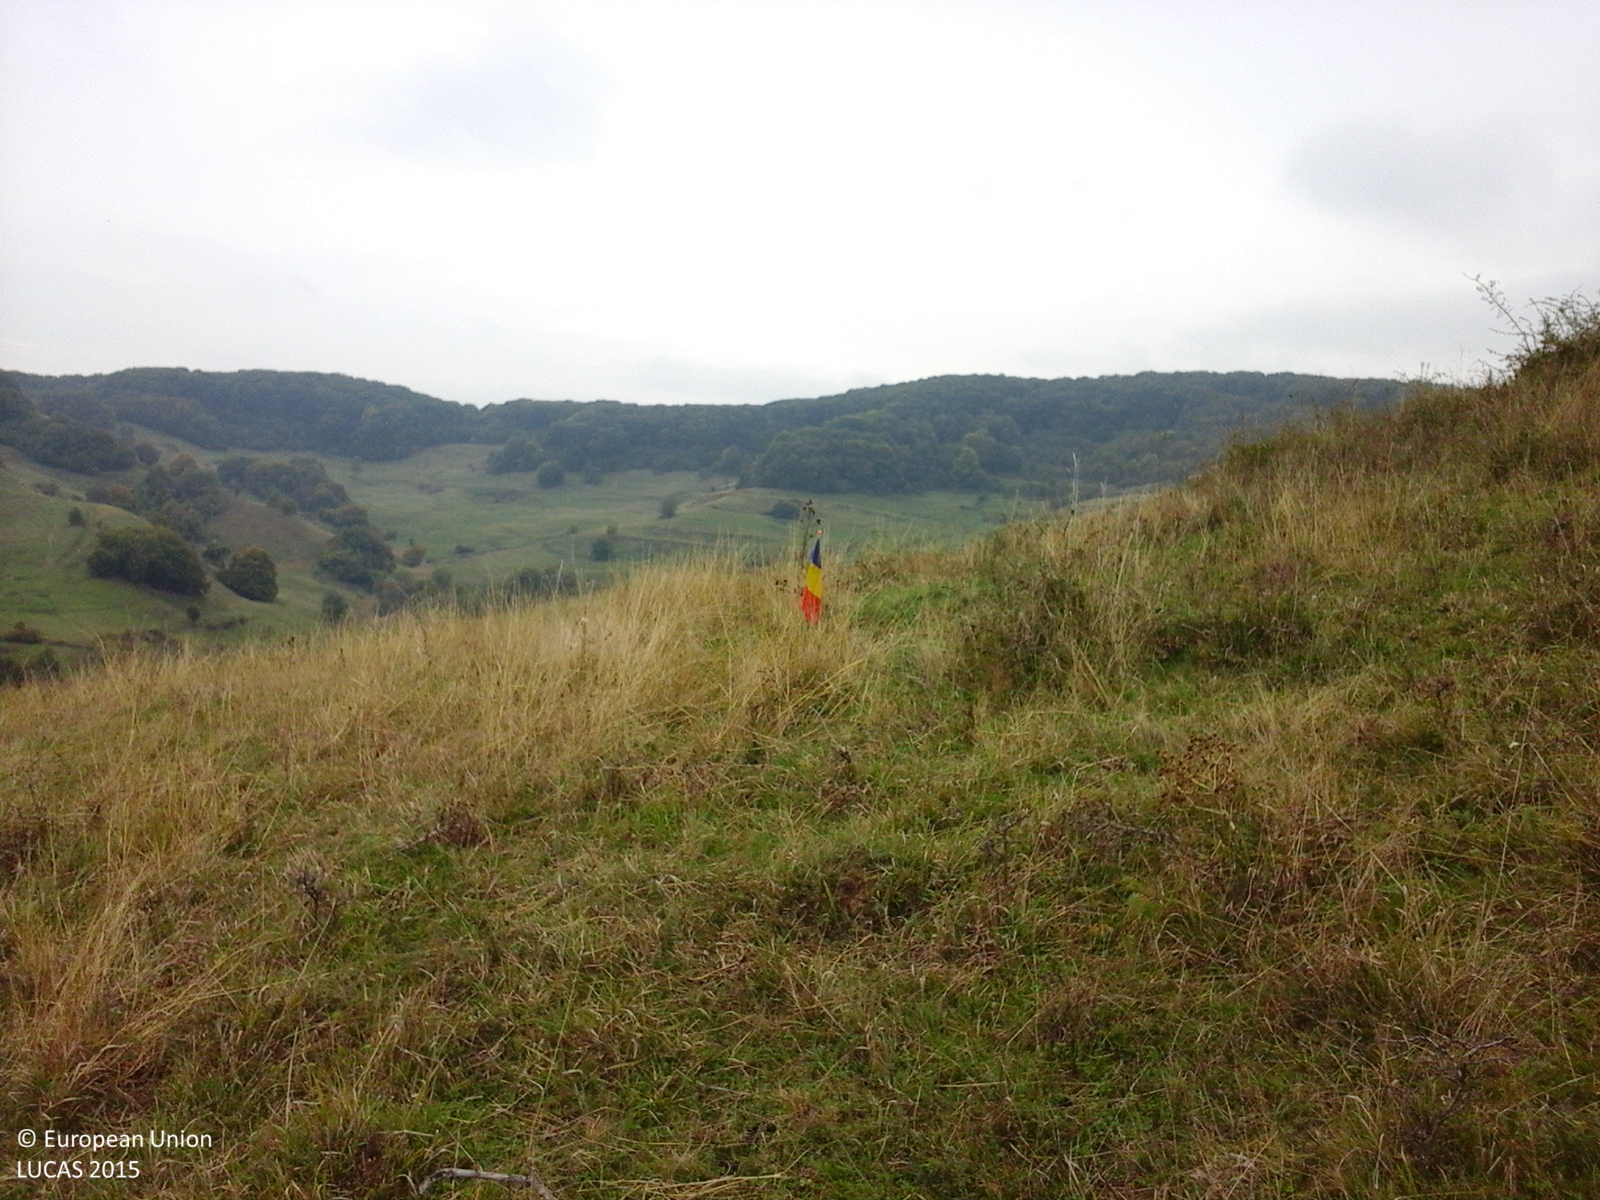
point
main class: Grassland
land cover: Grassland with sparse tree/shrub cover
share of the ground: > 75 %
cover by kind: herbaceous plants 85 %, shrubs 10 %, broadleaved forest trees 5 %
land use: Agriculture (excluding fallow land and kitchen gardens)
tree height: < 5 m
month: October
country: RO
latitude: 46.3201
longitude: 24.8068
